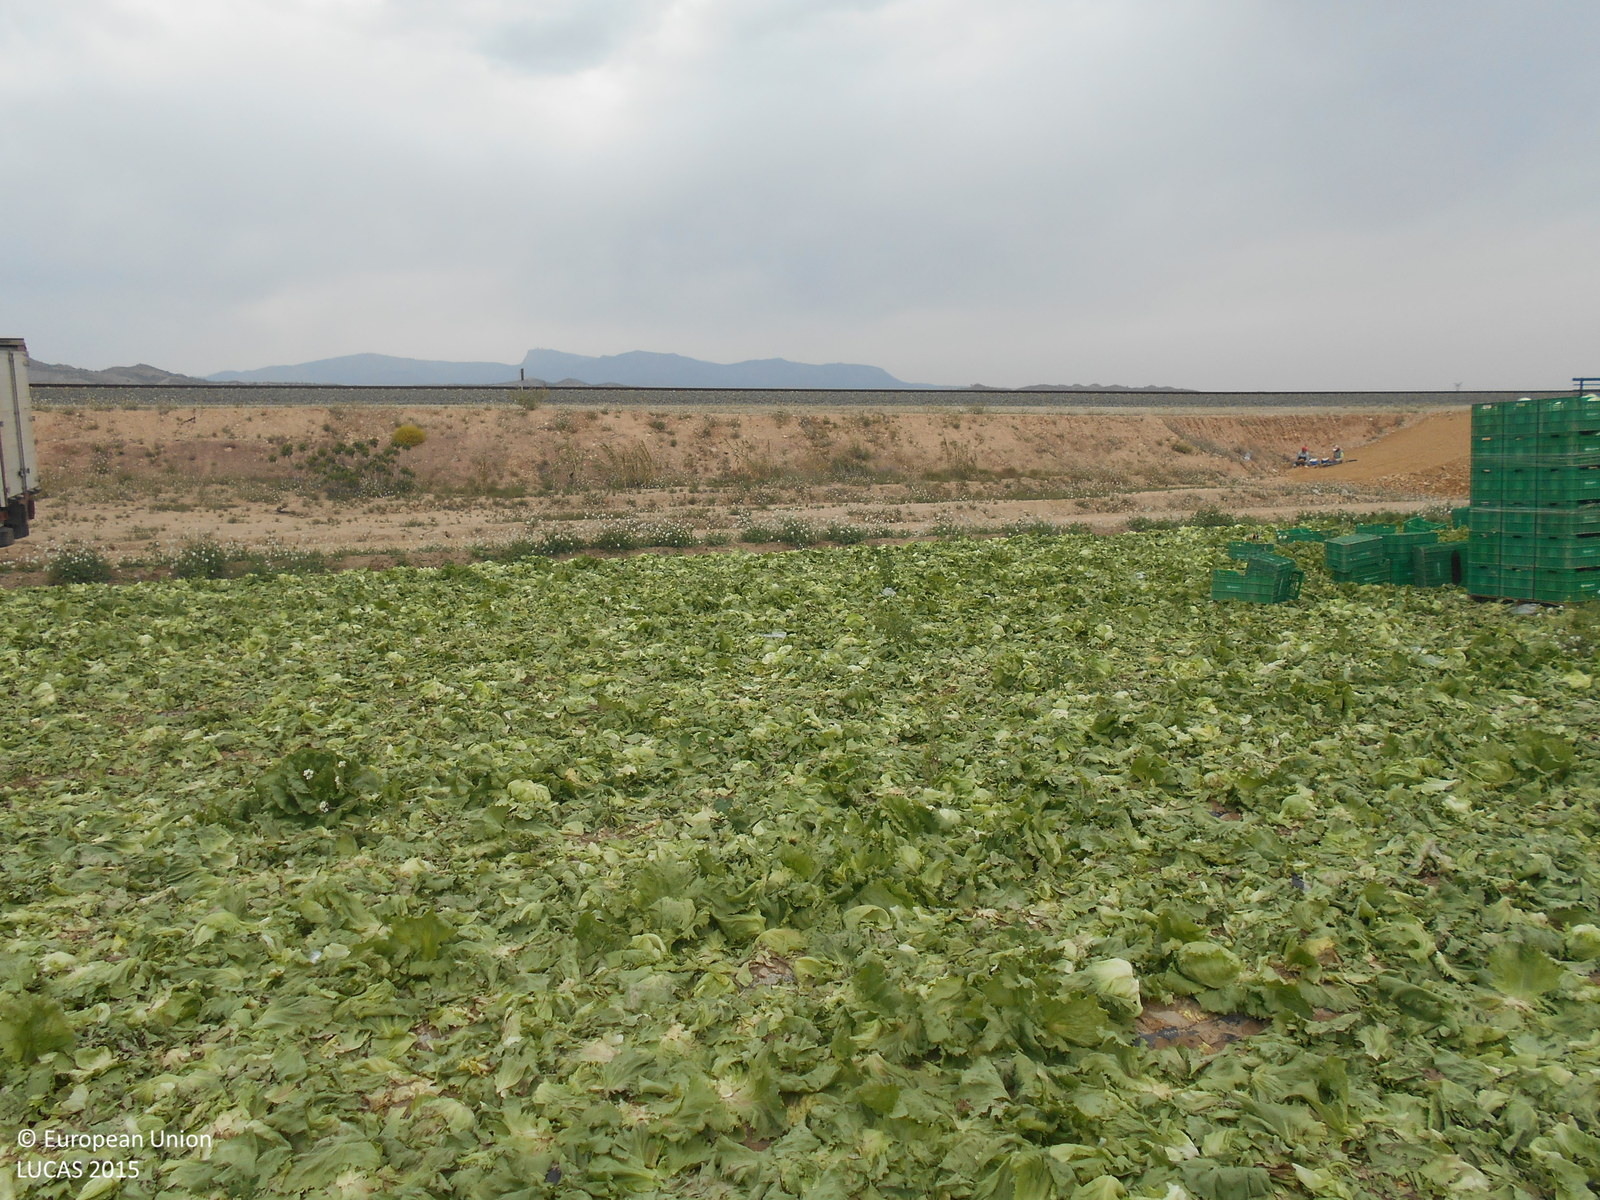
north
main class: Cropland
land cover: Other fresh vegetables
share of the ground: > 75 %
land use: Agriculture (excluding fallow land and kitchen gardens)
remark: Harvested field
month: April
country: ES
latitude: 37.7193
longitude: -1.5428
